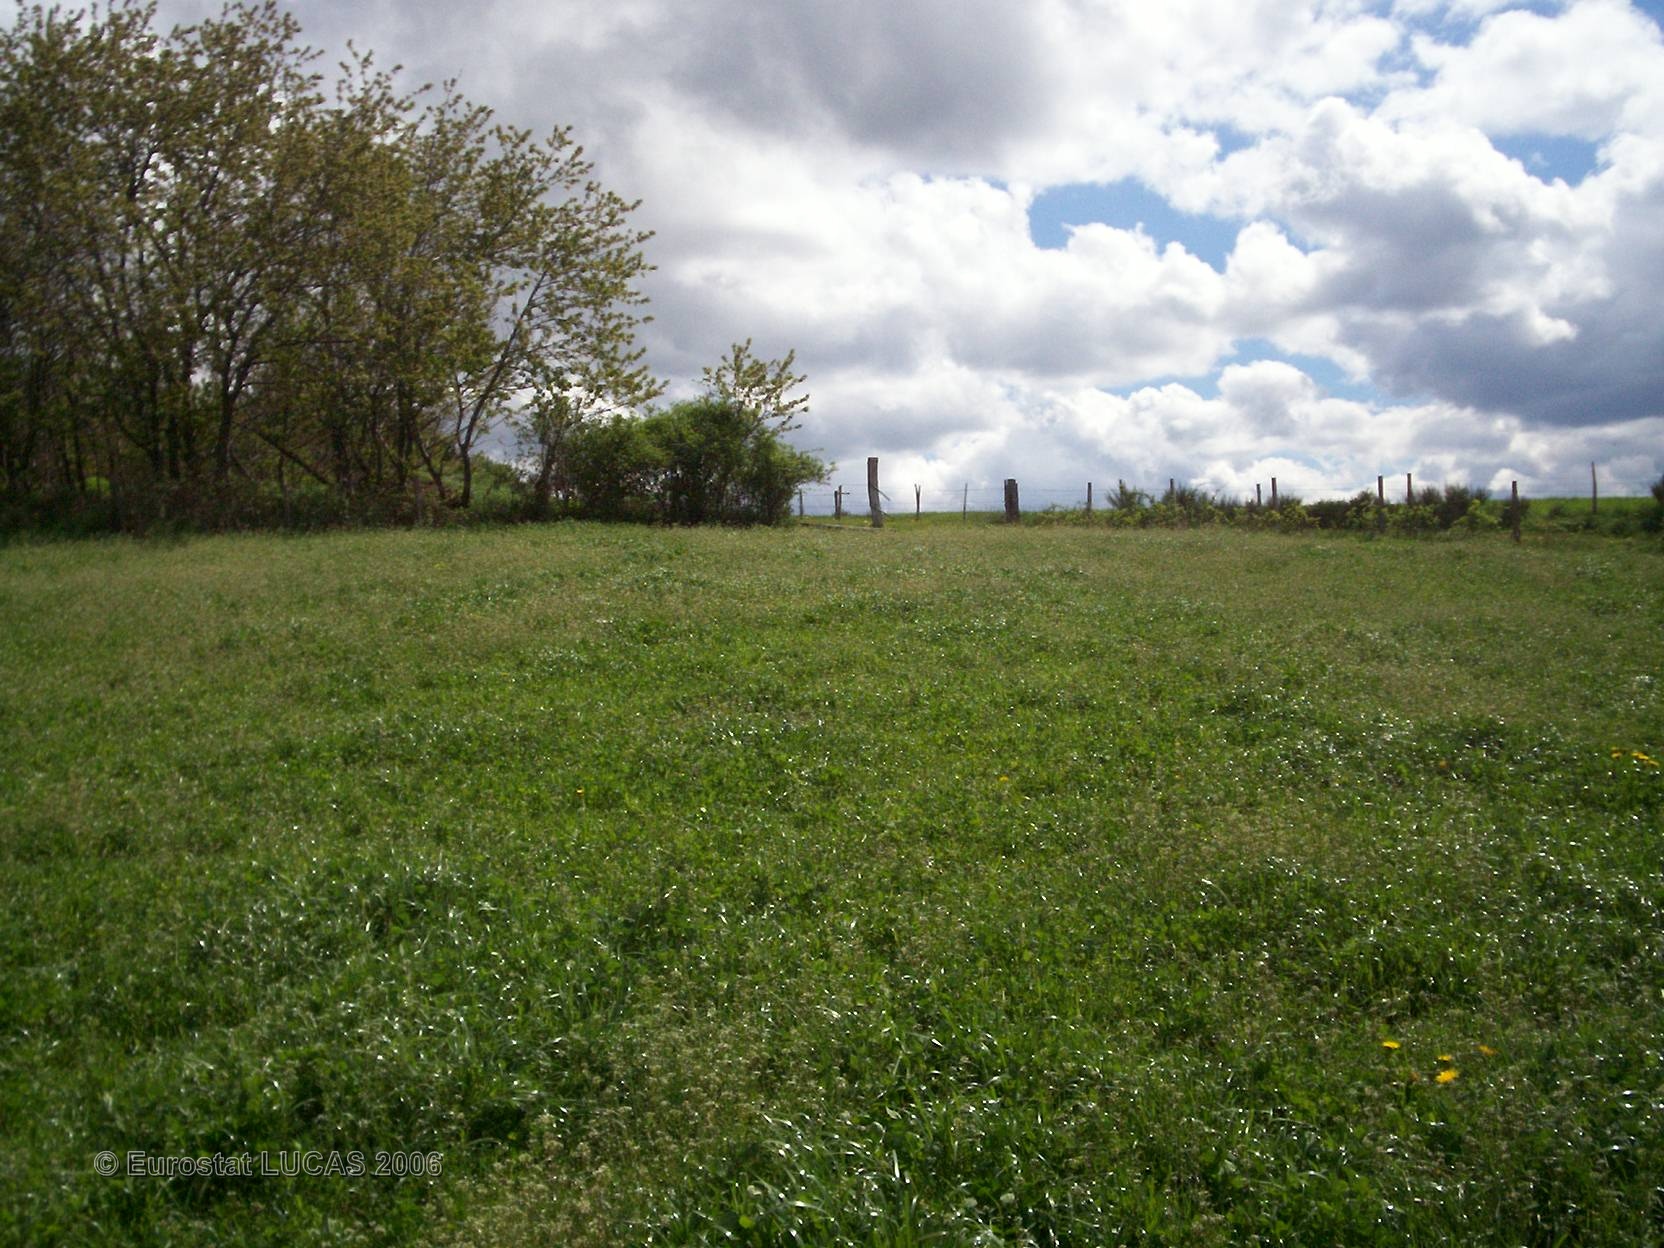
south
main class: Grassland
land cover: Grassland without tree/shrub cover
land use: Agriculture (excluding fallow land and kitchen gardens)
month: May
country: FR
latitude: 45.1859
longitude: 3.3462
